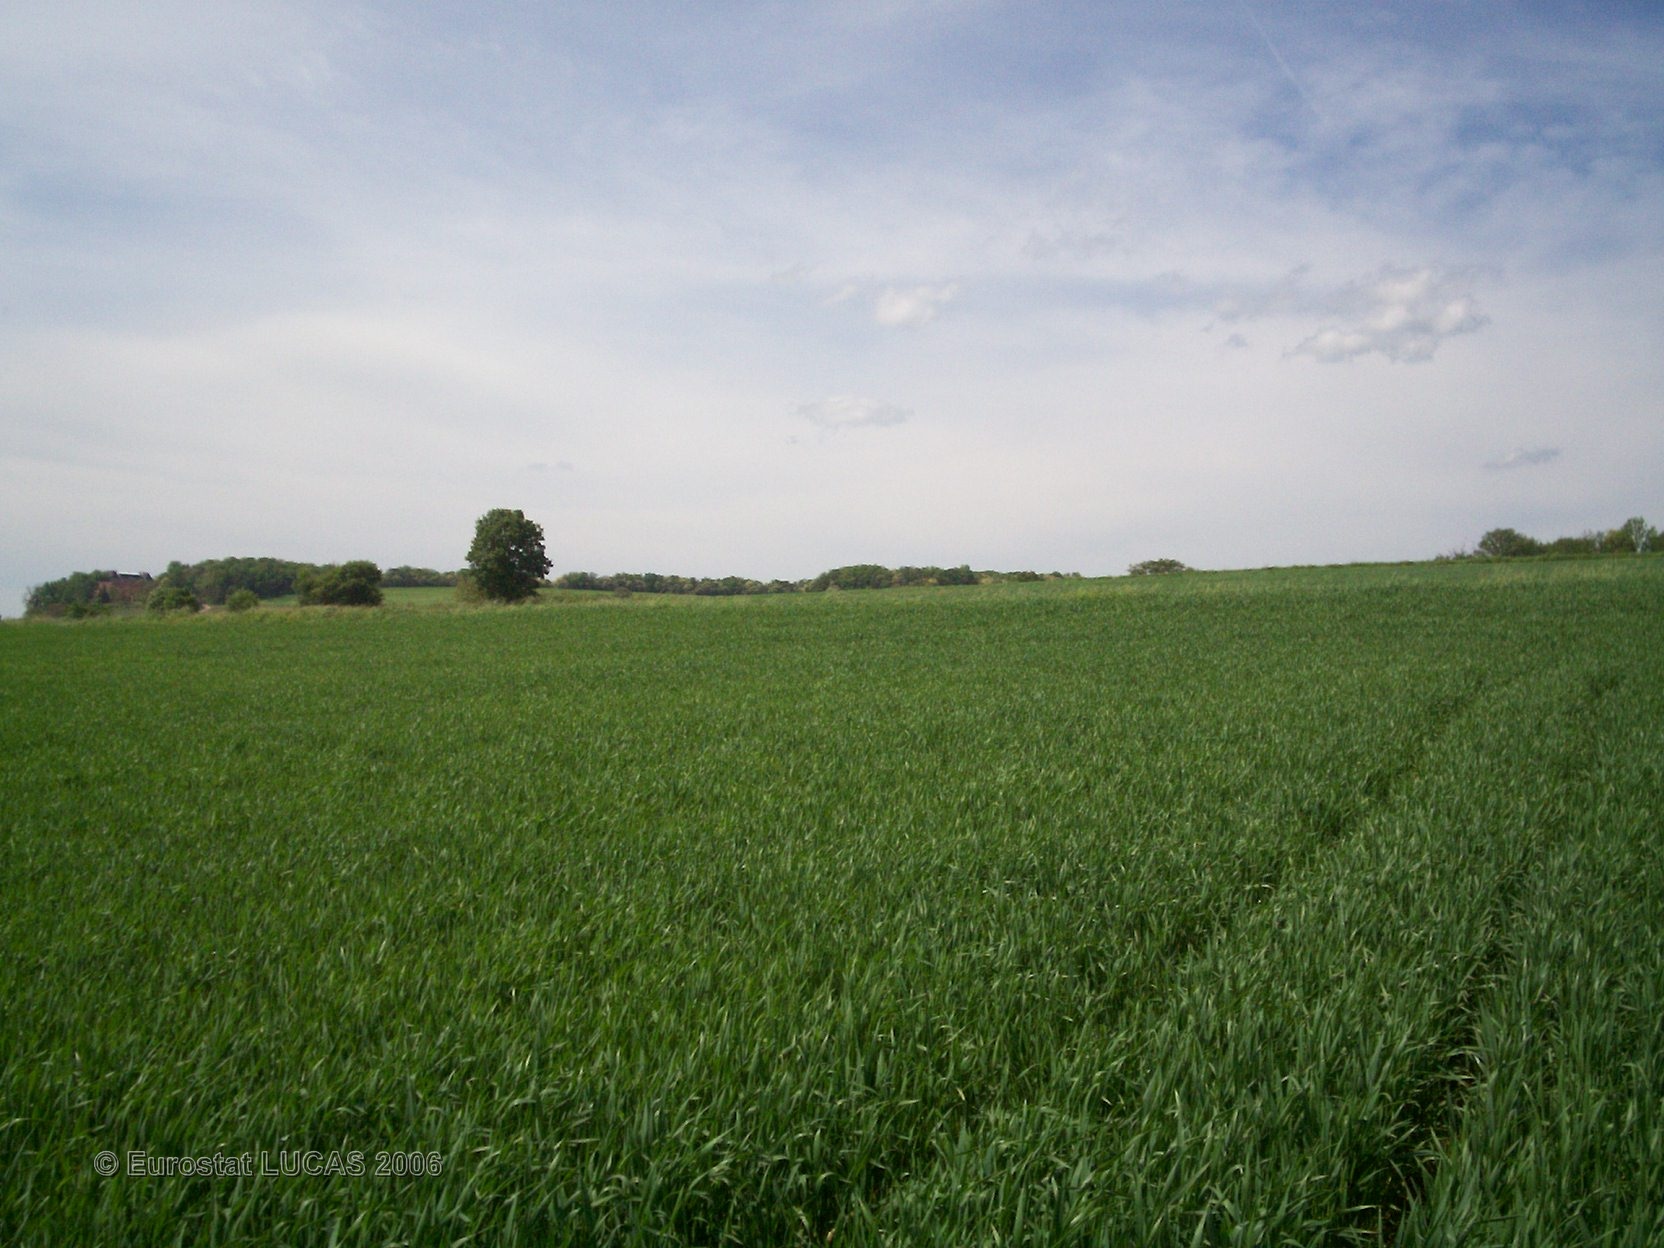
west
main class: Cropland
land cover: Common wheat
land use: Agriculture (excluding fallow land and kitchen gardens)
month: May
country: FR
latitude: 46.5636
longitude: 4.7181
